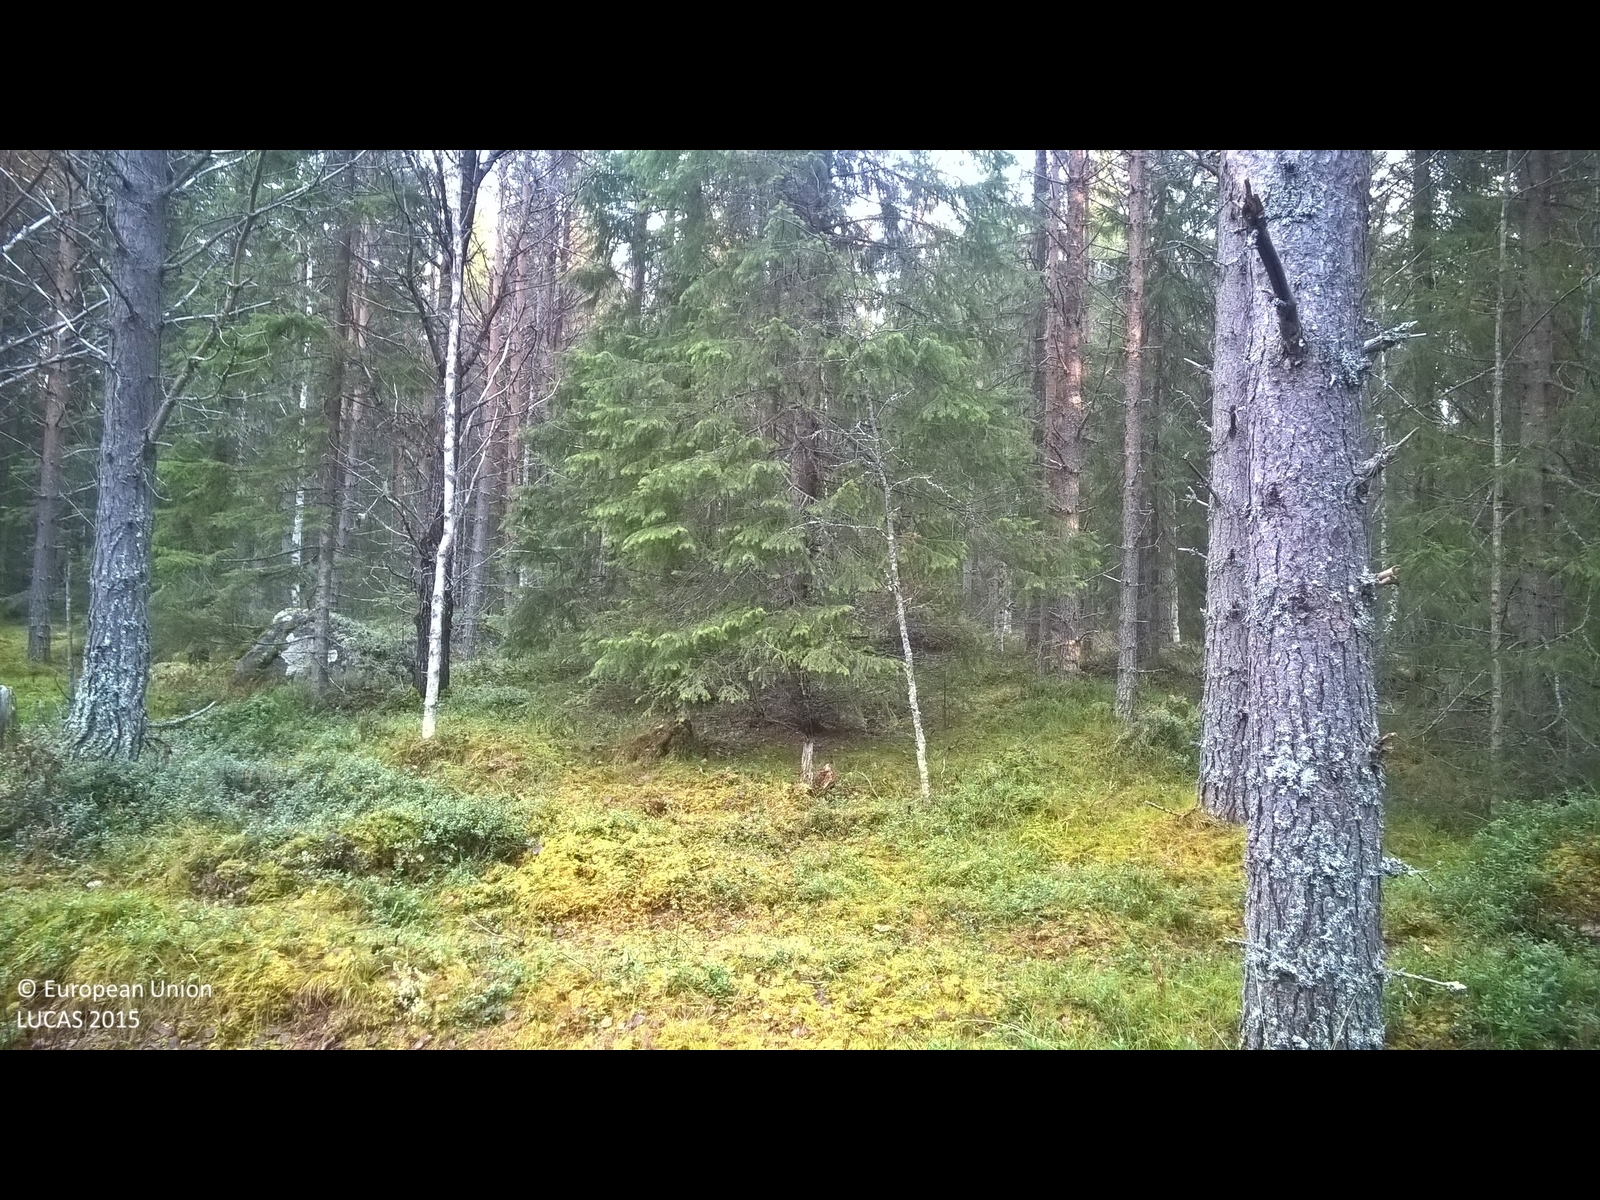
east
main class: Woodland
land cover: Spruce dominated mixed woodland
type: boreal forest
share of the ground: > 75 %
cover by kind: coniferous forest trees 40 %, broadleaved forest trees 40 %, lichens and mosses 20 %
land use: Forestry
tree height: > 5 m
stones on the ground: < 10 %
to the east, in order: Spruce dominated mixed woodland; Pine dominated mixed woodland; Tracks; Spruce dominated mixed woodland; Grassland without tree/shrub cover; Grass margins; Abandoned hedges; Grassland without tree/shrub cover
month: November
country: SE
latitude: 62.7599
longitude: 15.6379
